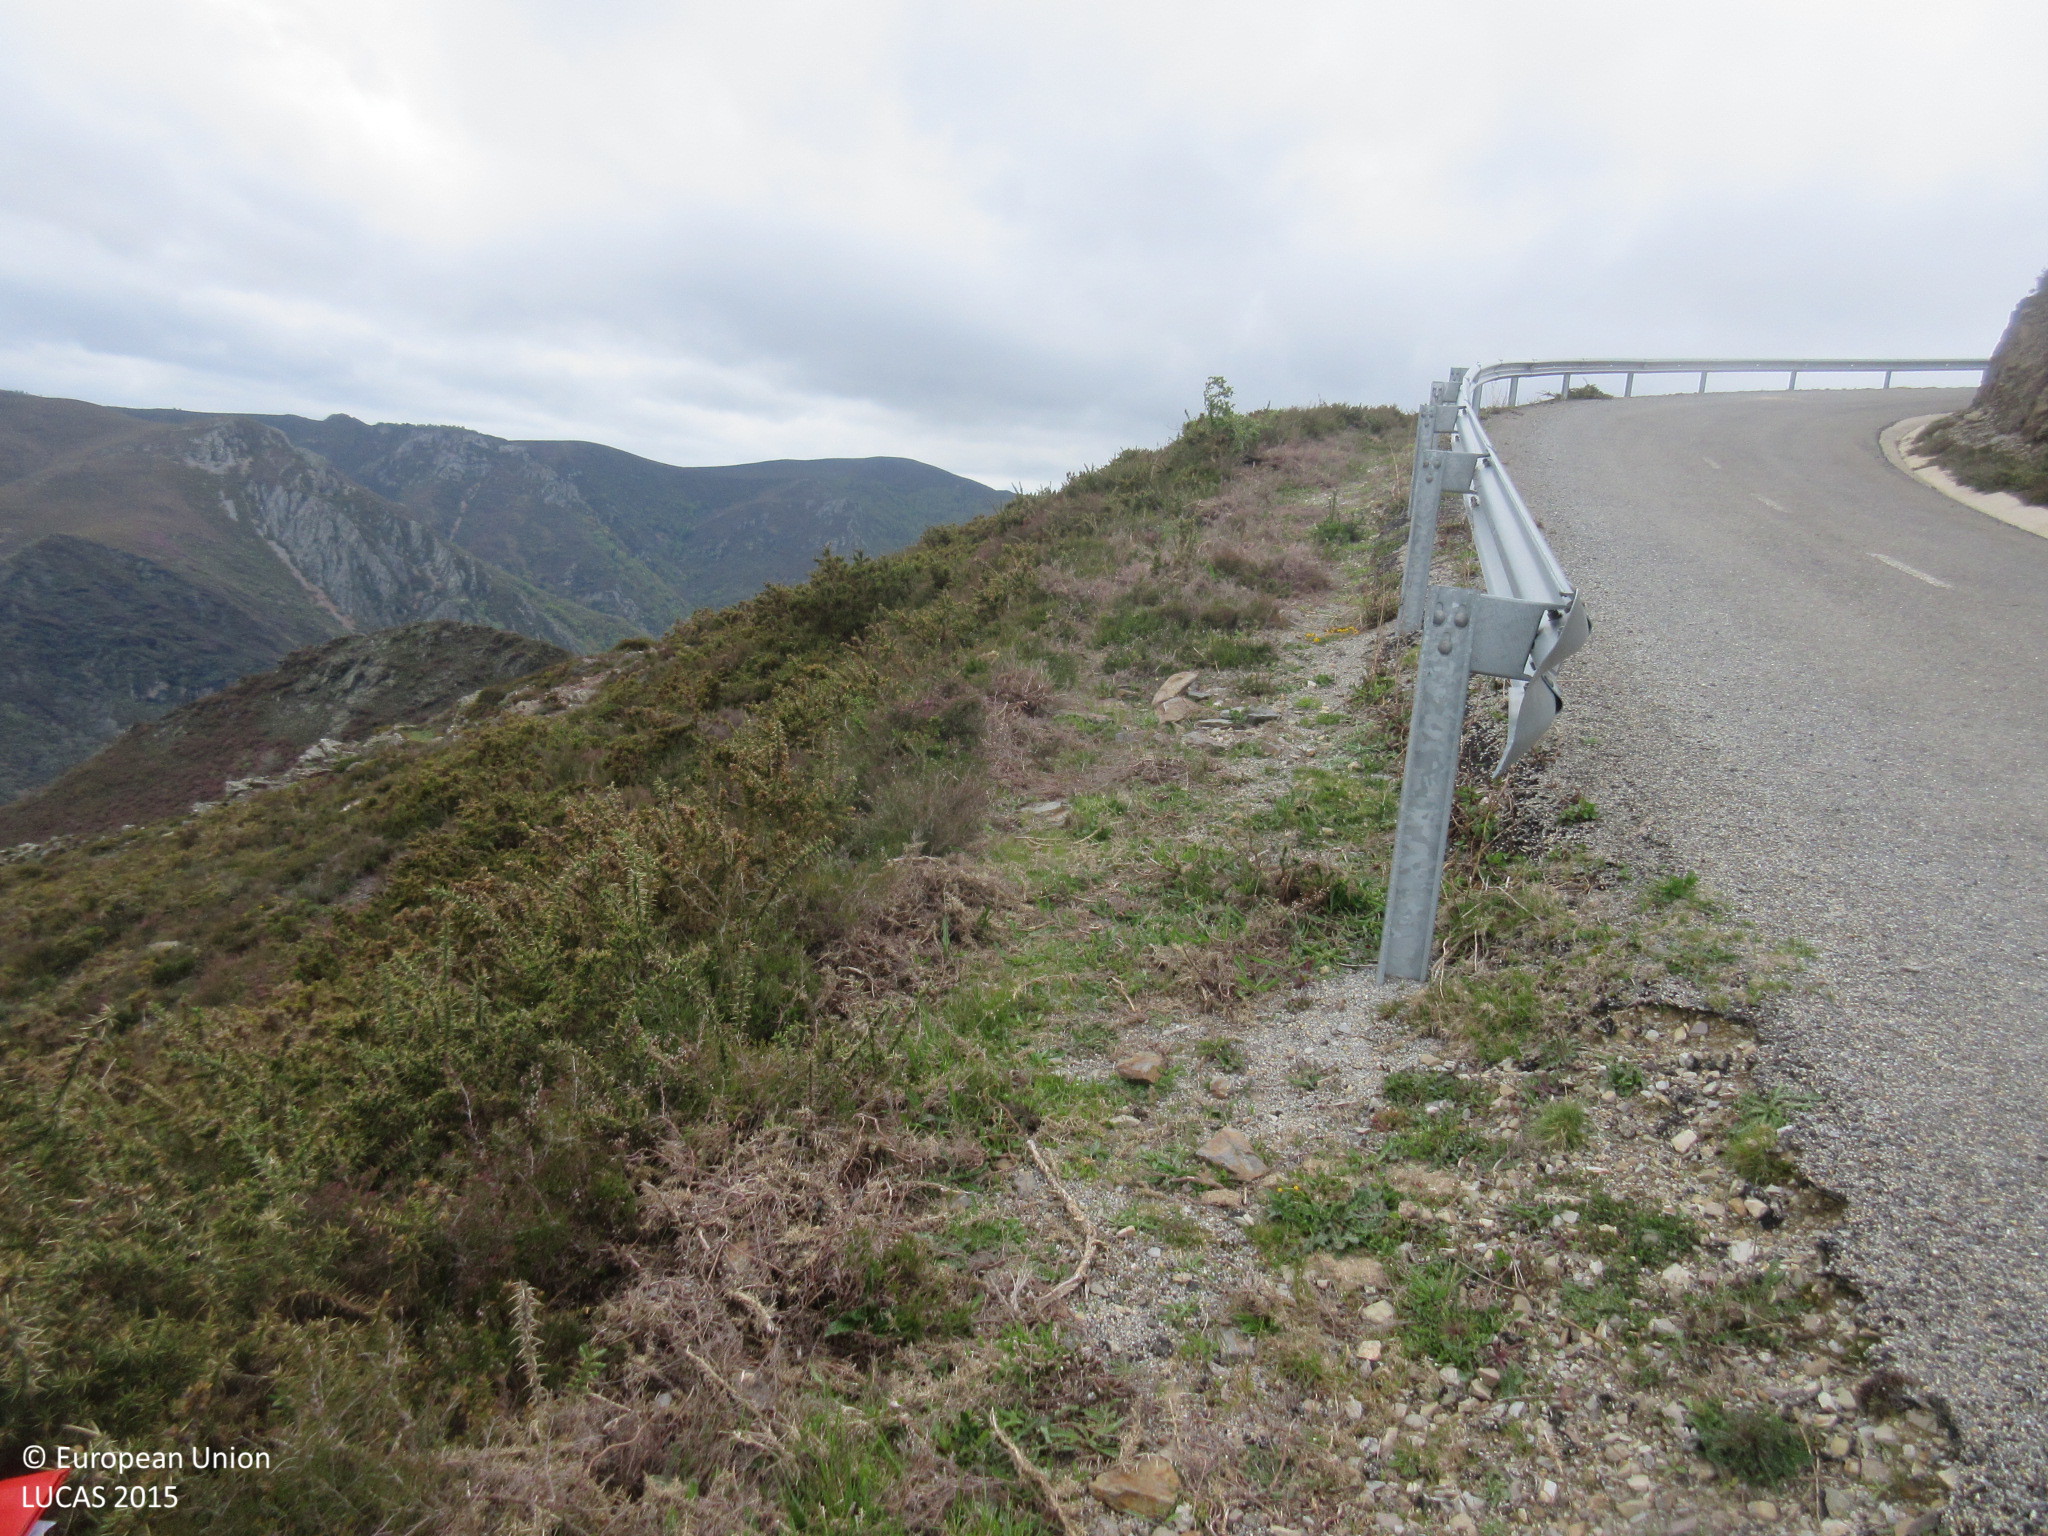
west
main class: Shrubland
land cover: Shrubland without tree cover
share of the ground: > 75 %
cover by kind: shrubs 100 %
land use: Semi-natural and natural areas not in use
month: April
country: ES
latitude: 43.3344
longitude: -6.9244
